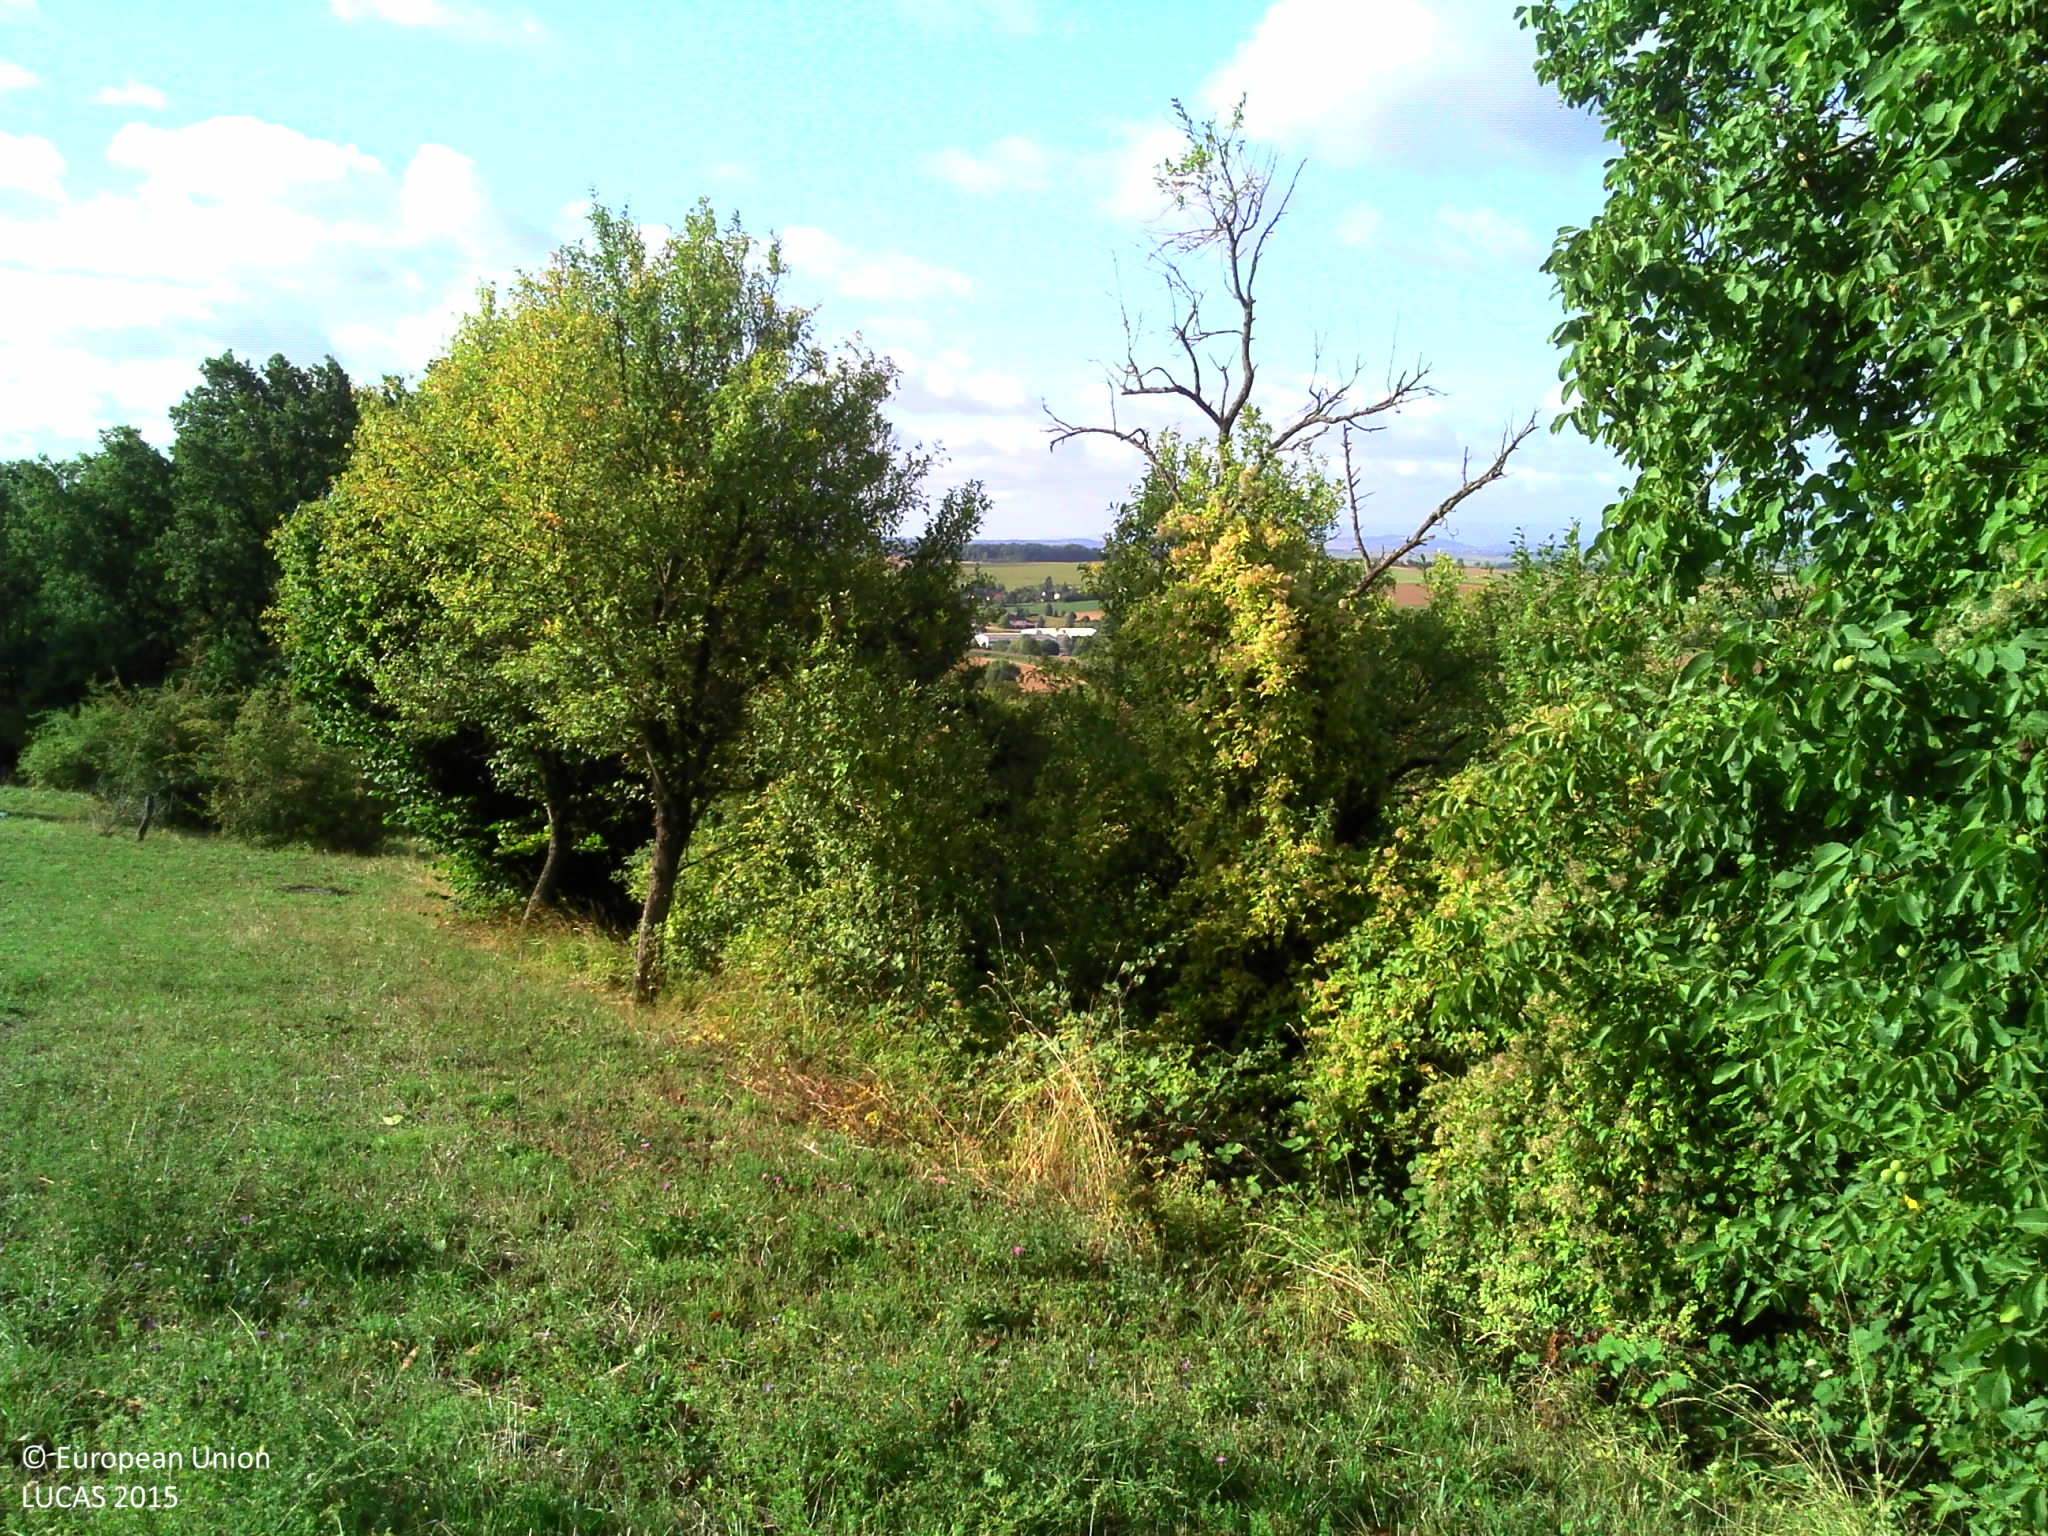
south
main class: Grassland
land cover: Grassland without tree/shrub cover
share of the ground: > 75 %
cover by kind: herbaceous plants 100 %
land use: Agriculture (excluding fallow land and kitchen gardens)
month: August
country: FR
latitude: 48.8092
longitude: 7.5905
